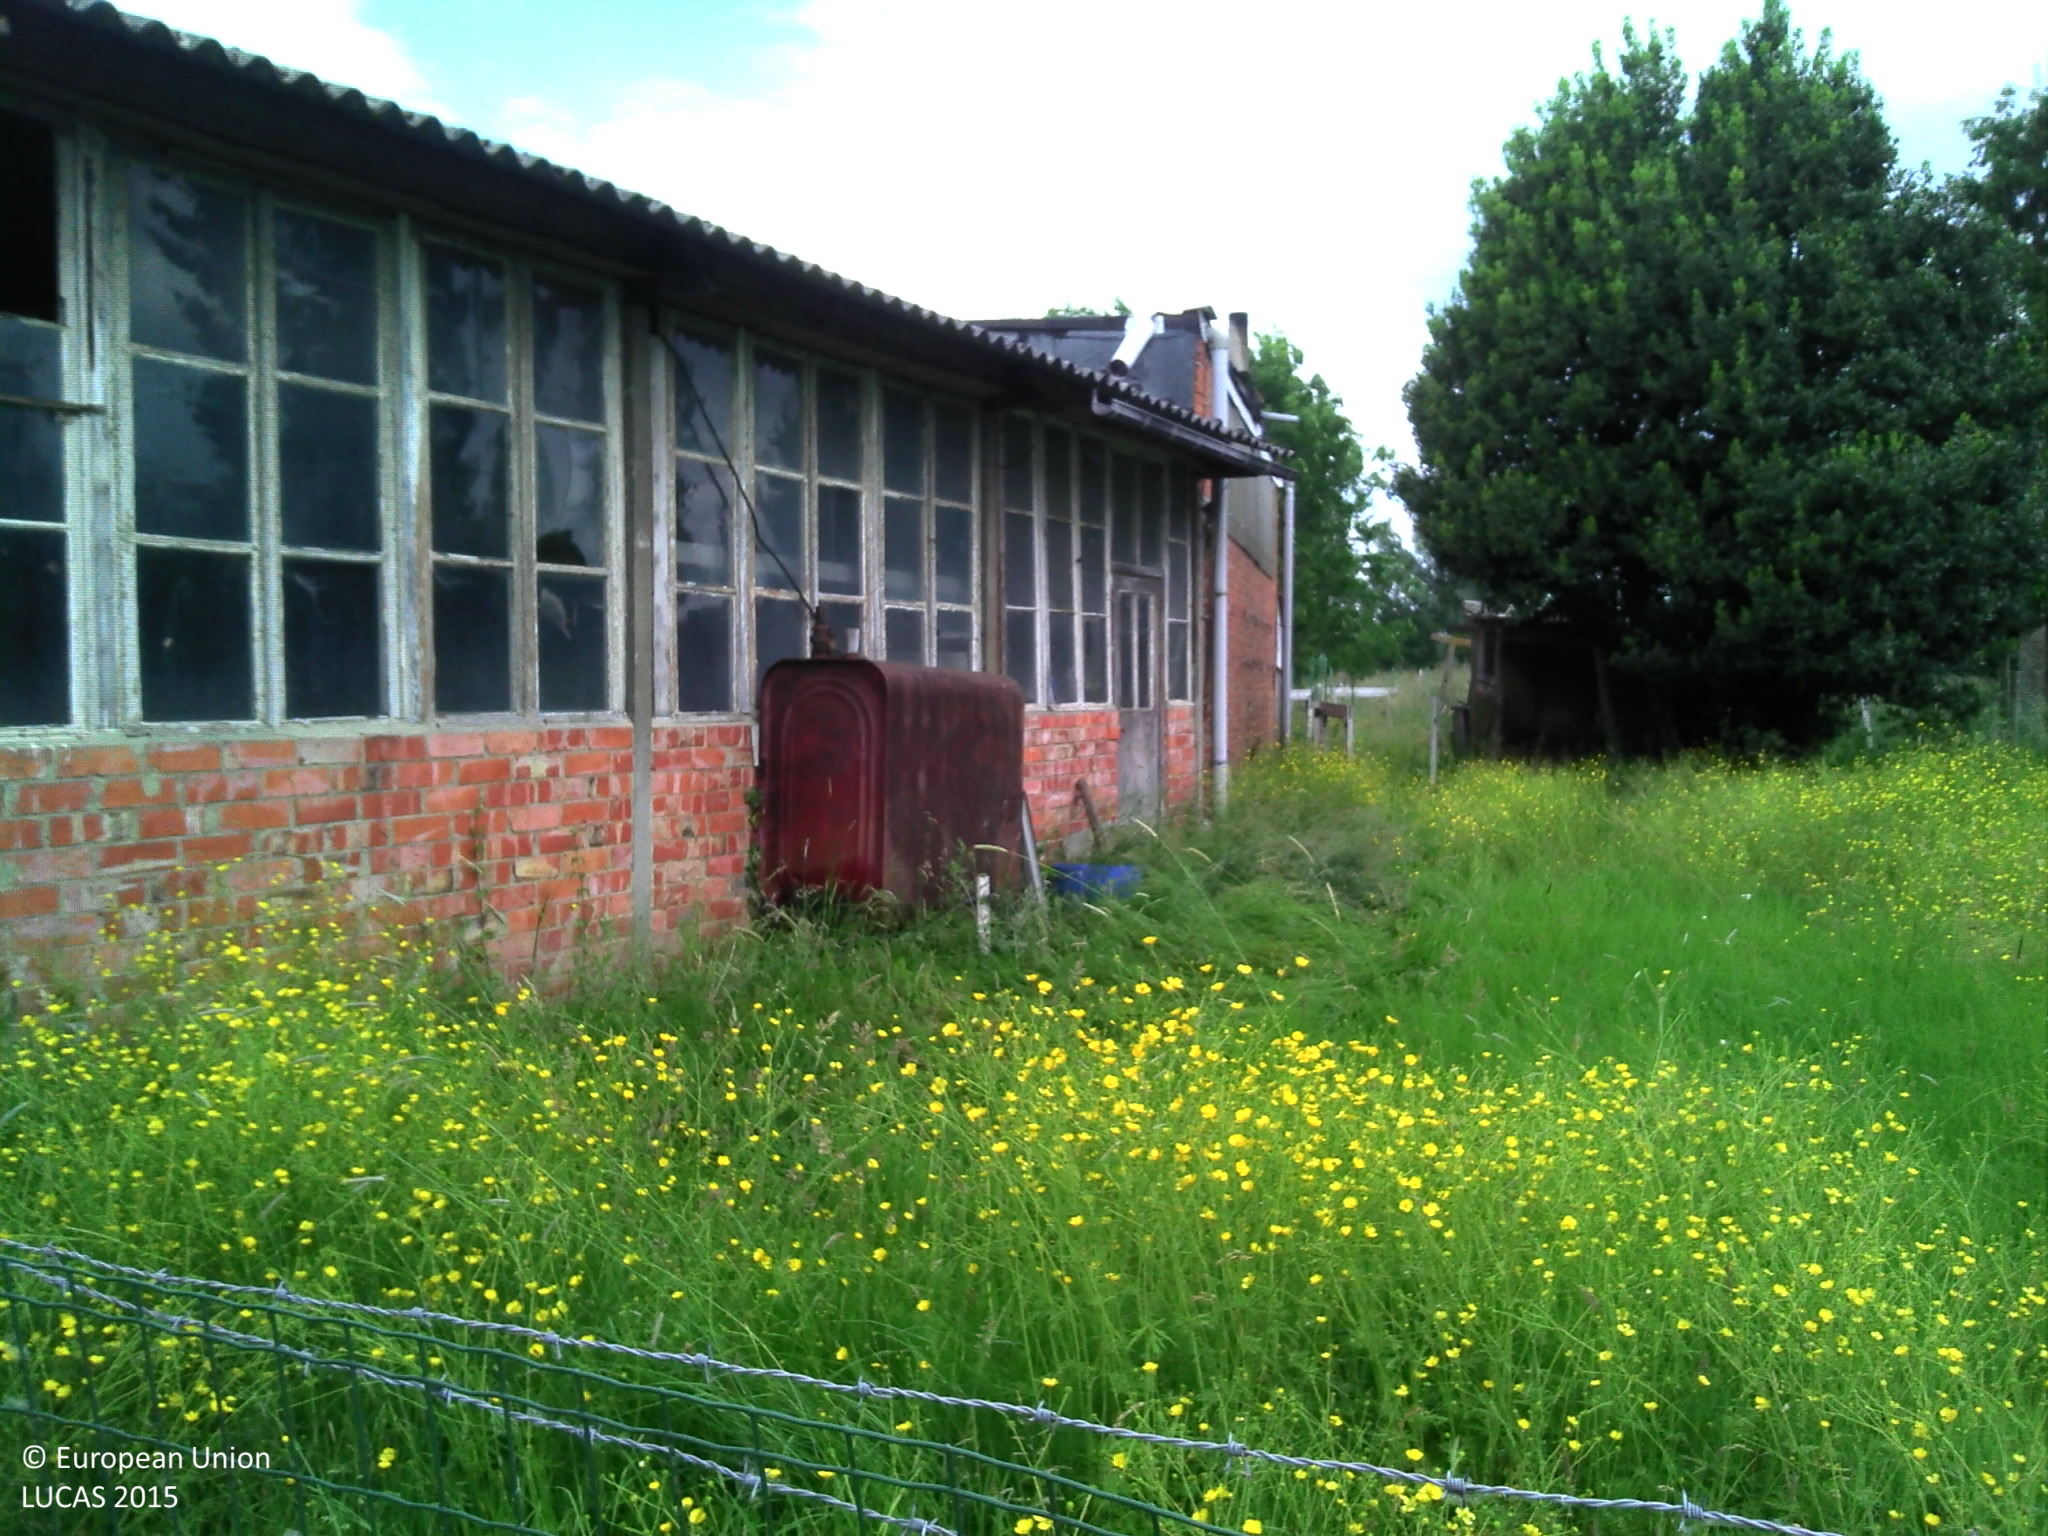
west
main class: Grassland
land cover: Grassland with sparse tree/shrub cover
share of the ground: > 75 %
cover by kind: herbaceous plants 95 %, broadleaved forest trees 5 %
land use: Residential
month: June
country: BE
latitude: 50.9653
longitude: 4.0281
